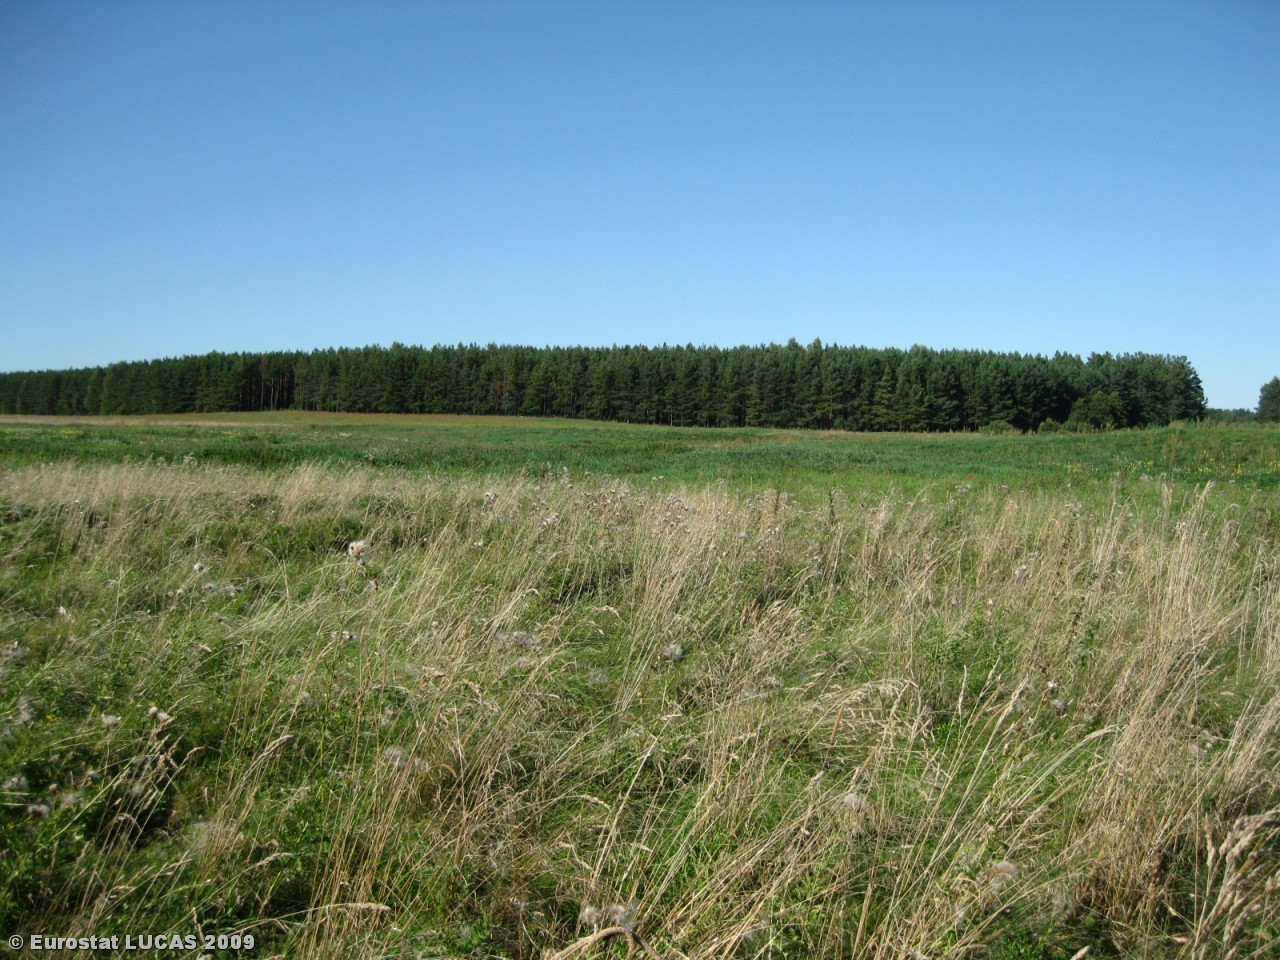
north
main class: Grassland
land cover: Spontaneously vegetated surfaces
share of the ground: > 75 %
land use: Unused
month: August
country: LT
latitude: 54.3875
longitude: 24.6591
